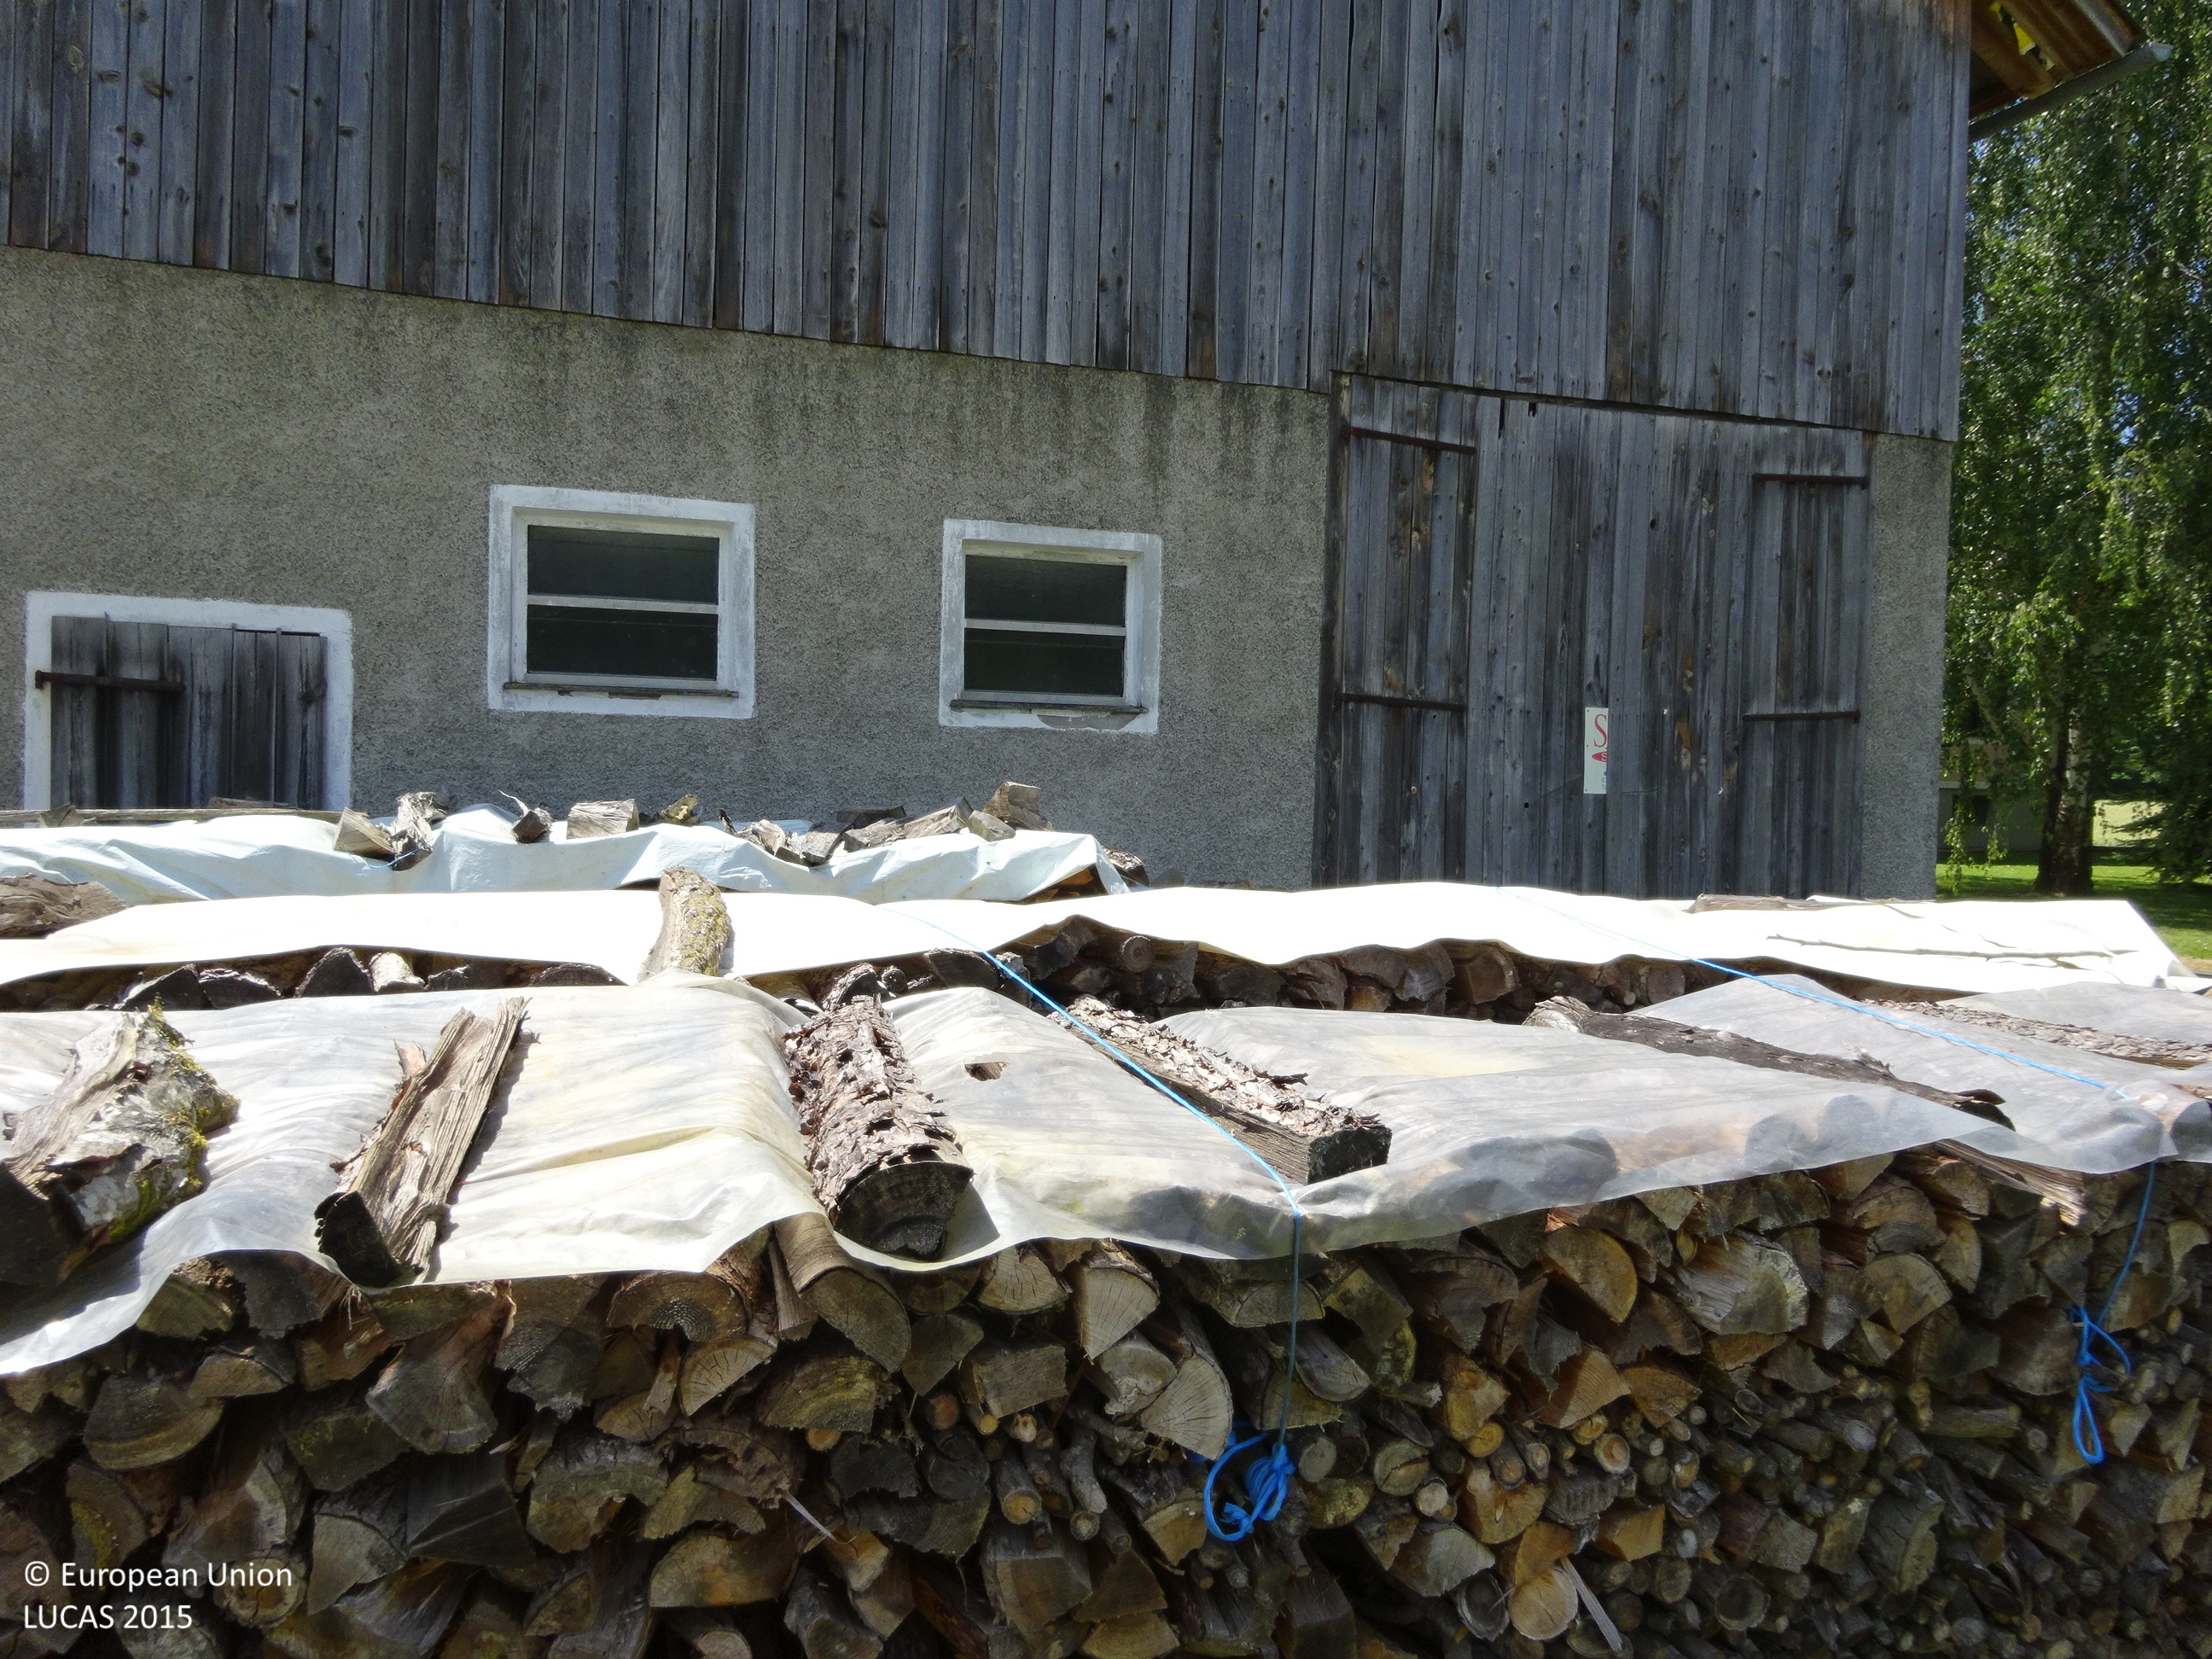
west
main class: Grassland
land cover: Grassland without tree/shrub cover
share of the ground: > 75 %
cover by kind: herbaceous plants 100 %
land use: Agriculture (excluding fallow land and kitchen gardens)
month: June
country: AT
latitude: 46.7644
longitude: 15.9317
